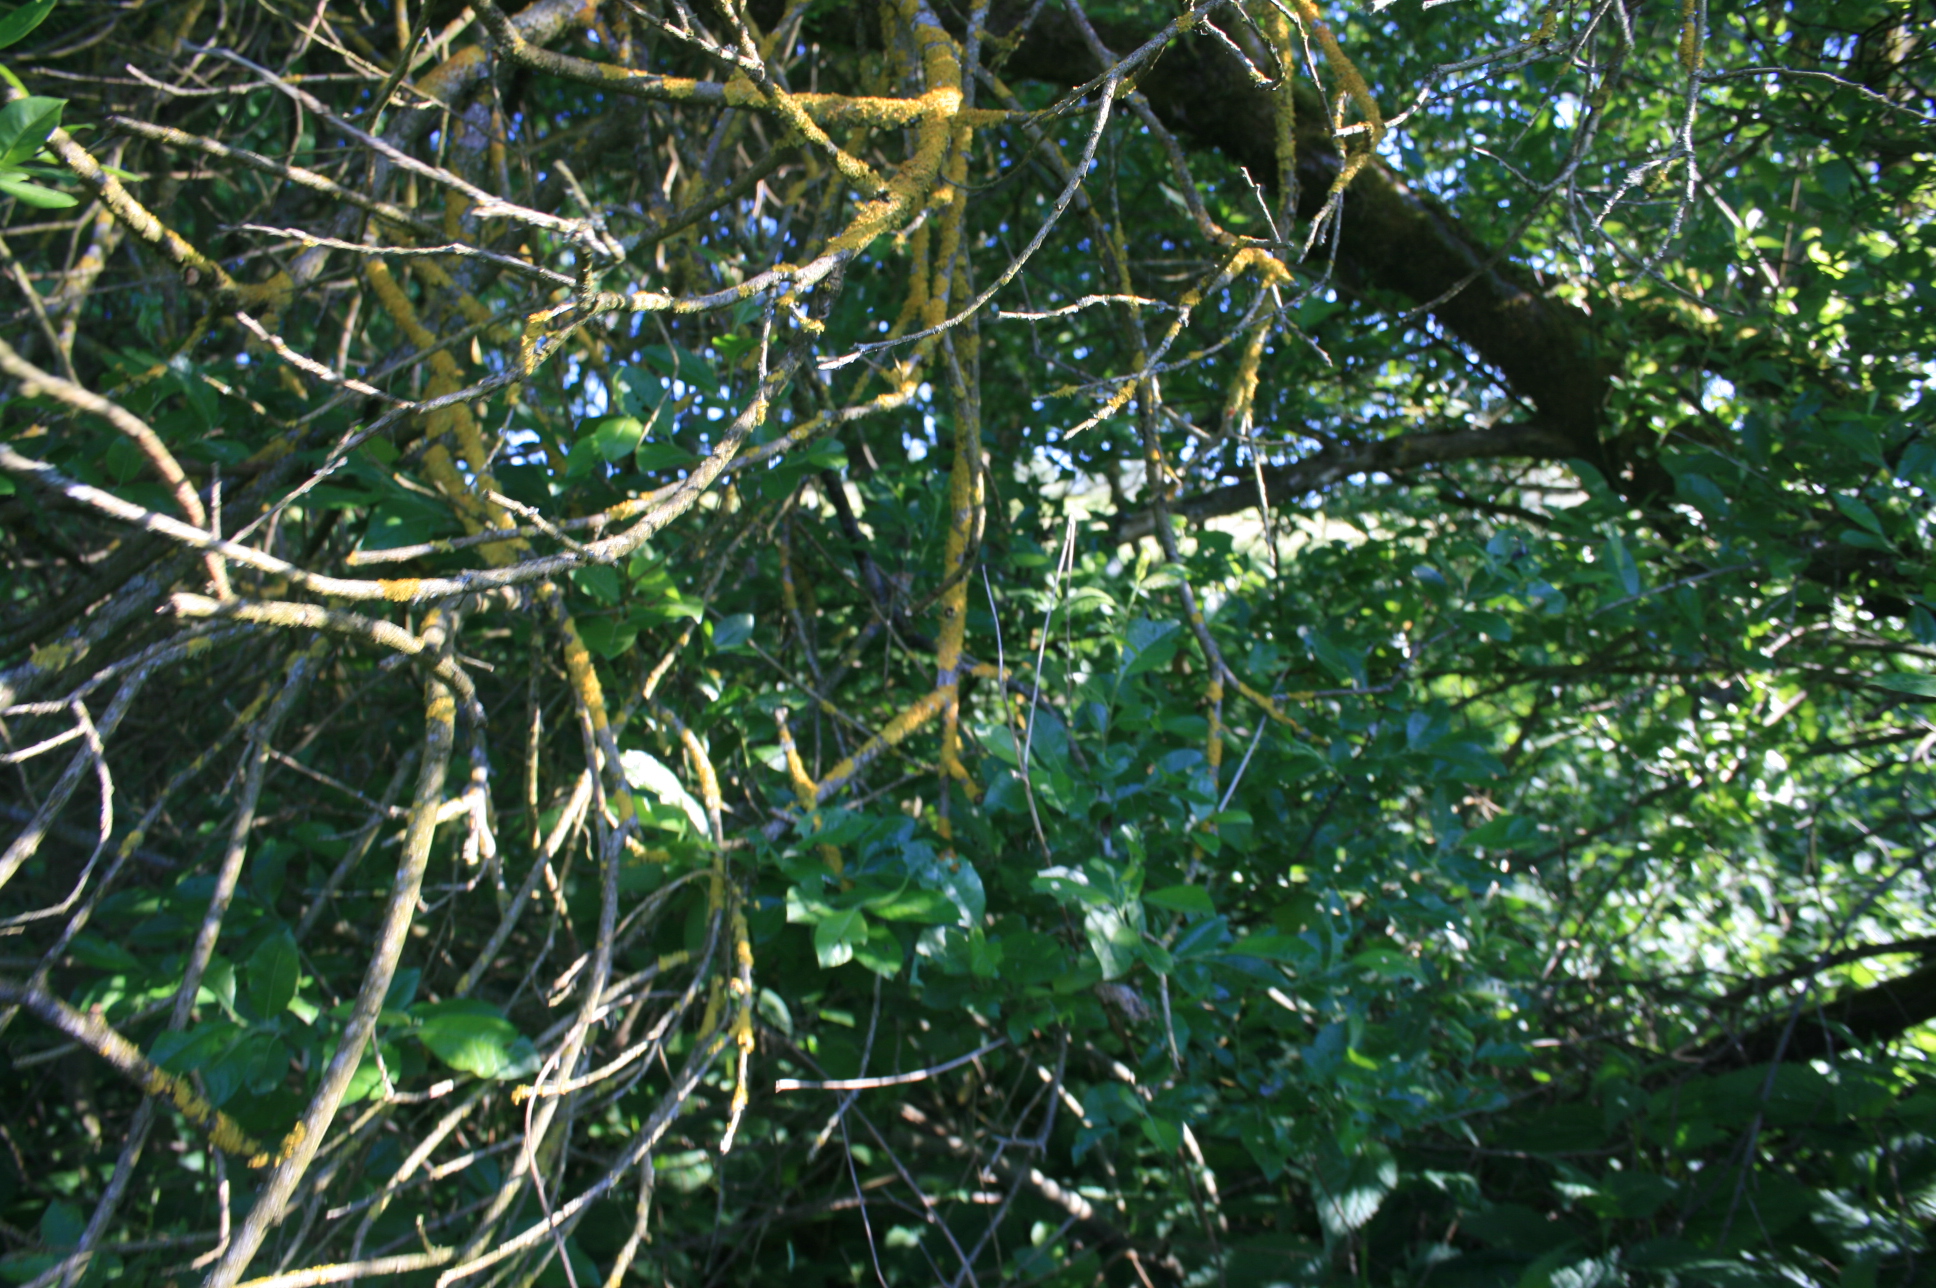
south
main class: Woodland
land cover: Broadleaved woodland
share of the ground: > 75 %
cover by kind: broadleaved forest trees 95 %, herbaceous plants 5 %
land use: Semi-natural and natural areas not in use
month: June
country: LT
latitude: 55.5825
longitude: 22.2239
